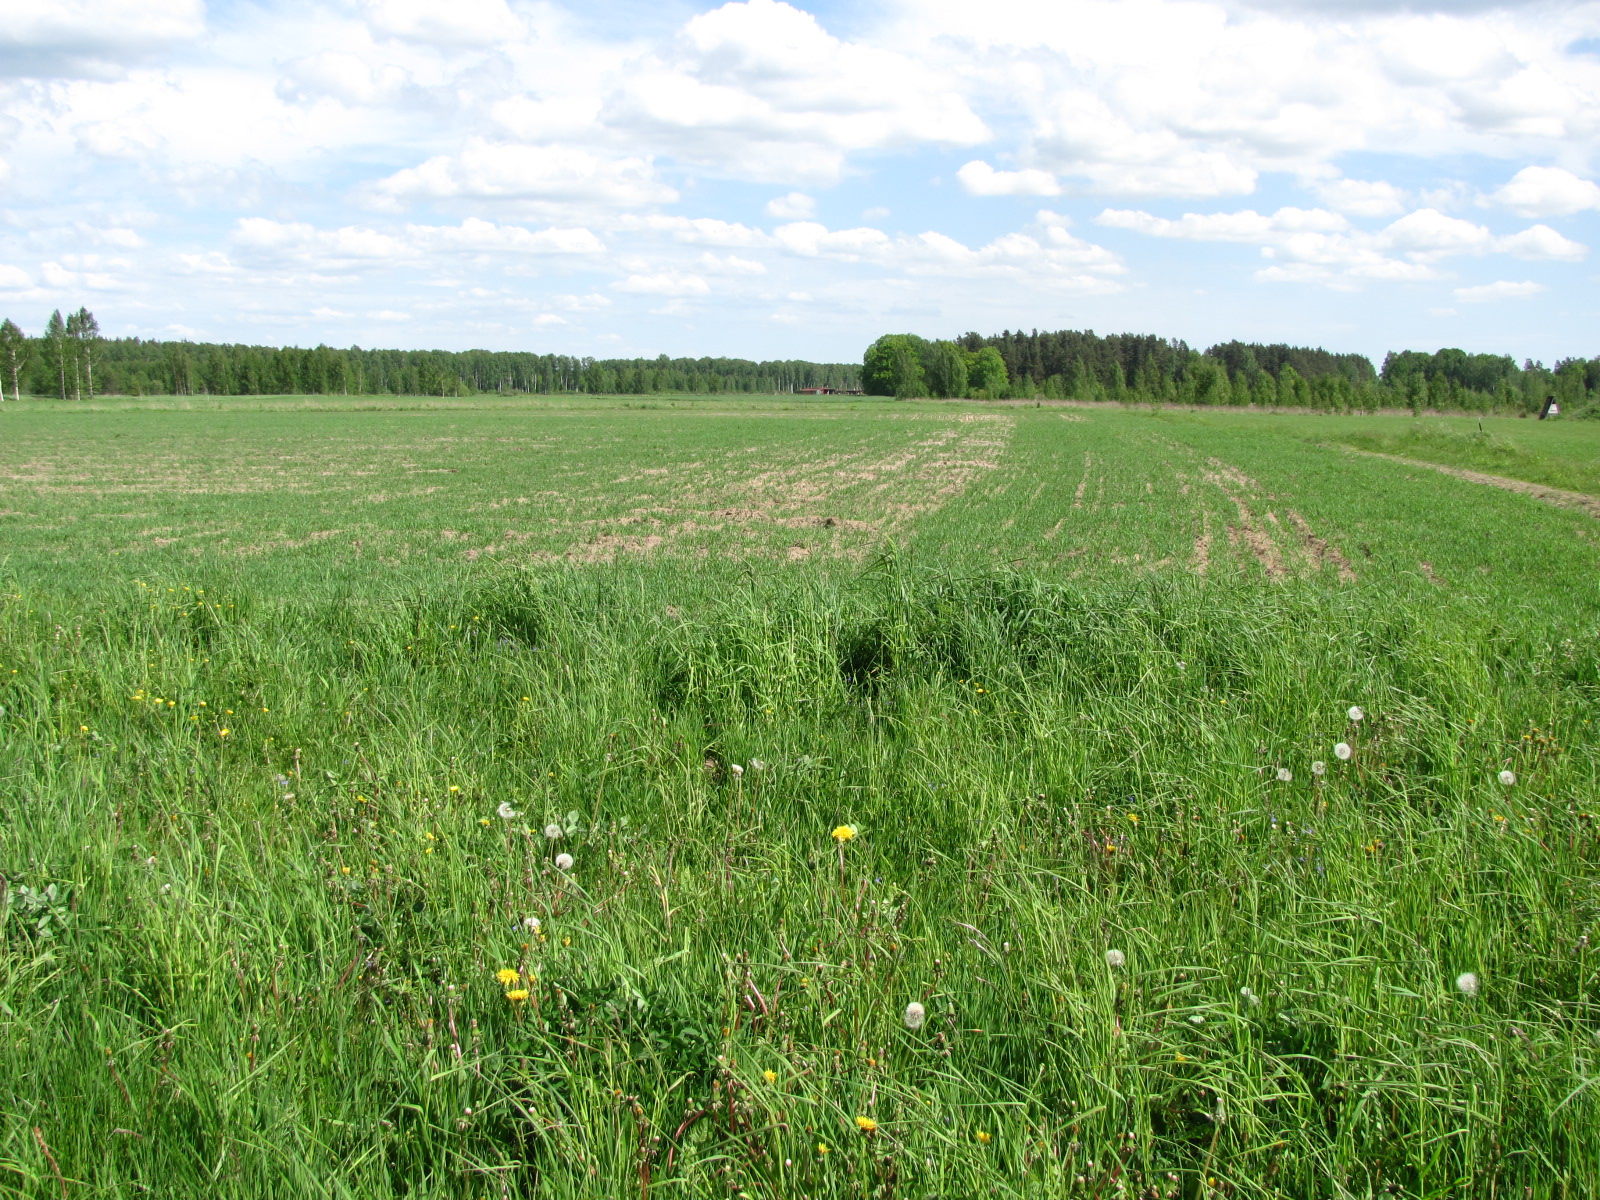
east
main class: Grassland
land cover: Grassland without tree/shrub cover
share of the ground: > 75 %
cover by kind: herbaceous plants 100 %
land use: Agriculture (excluding fallow land and kitchen gardens)
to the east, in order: Grassland without tree/shrub cover; Barley; Grassland without tree/shrub cover; Tracks; Barley
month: May
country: LV
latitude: 56.6267
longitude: 23.9547
